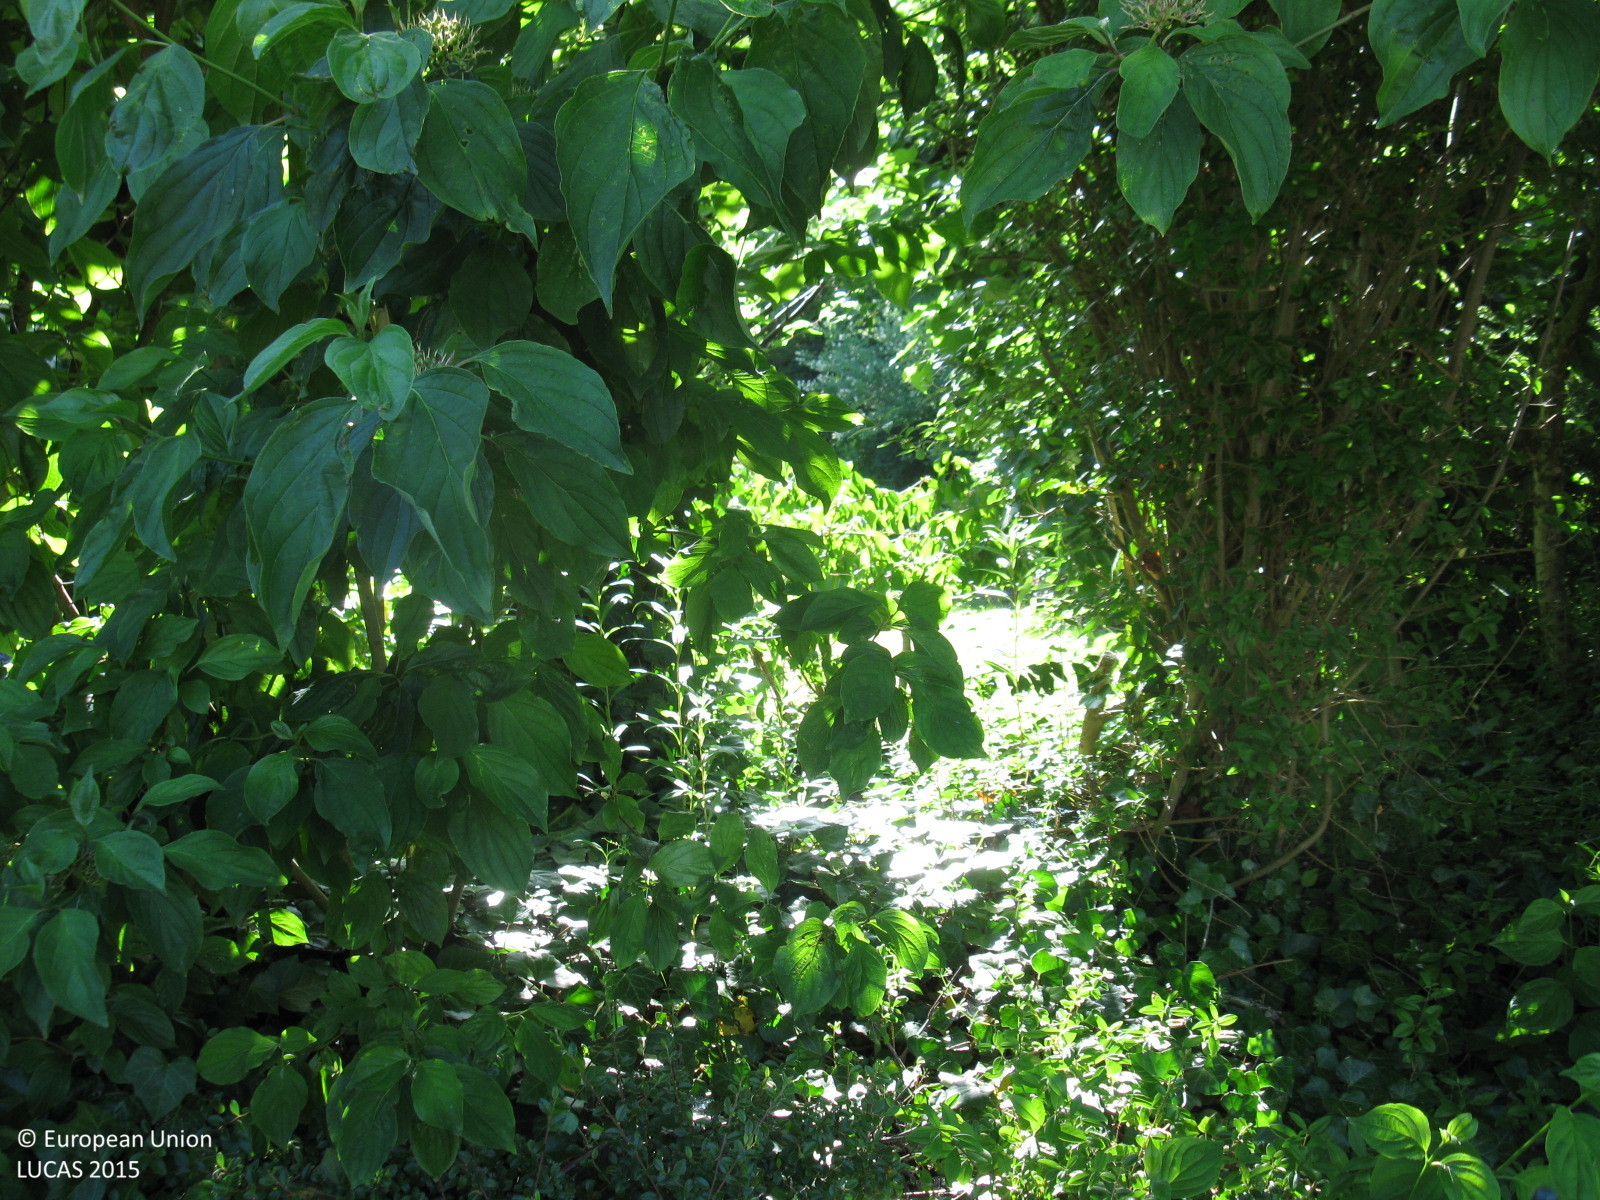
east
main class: Grassland
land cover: Grassland without tree/shrub cover
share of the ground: > 75 %
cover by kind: herbaceous plants 100 %
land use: Residential
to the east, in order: Grassland without tree/shrub cover; Artificial constructions in urban areas; Pine dominated coniferous woodland
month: June
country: DE
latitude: 52.8889
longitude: 8.4697
